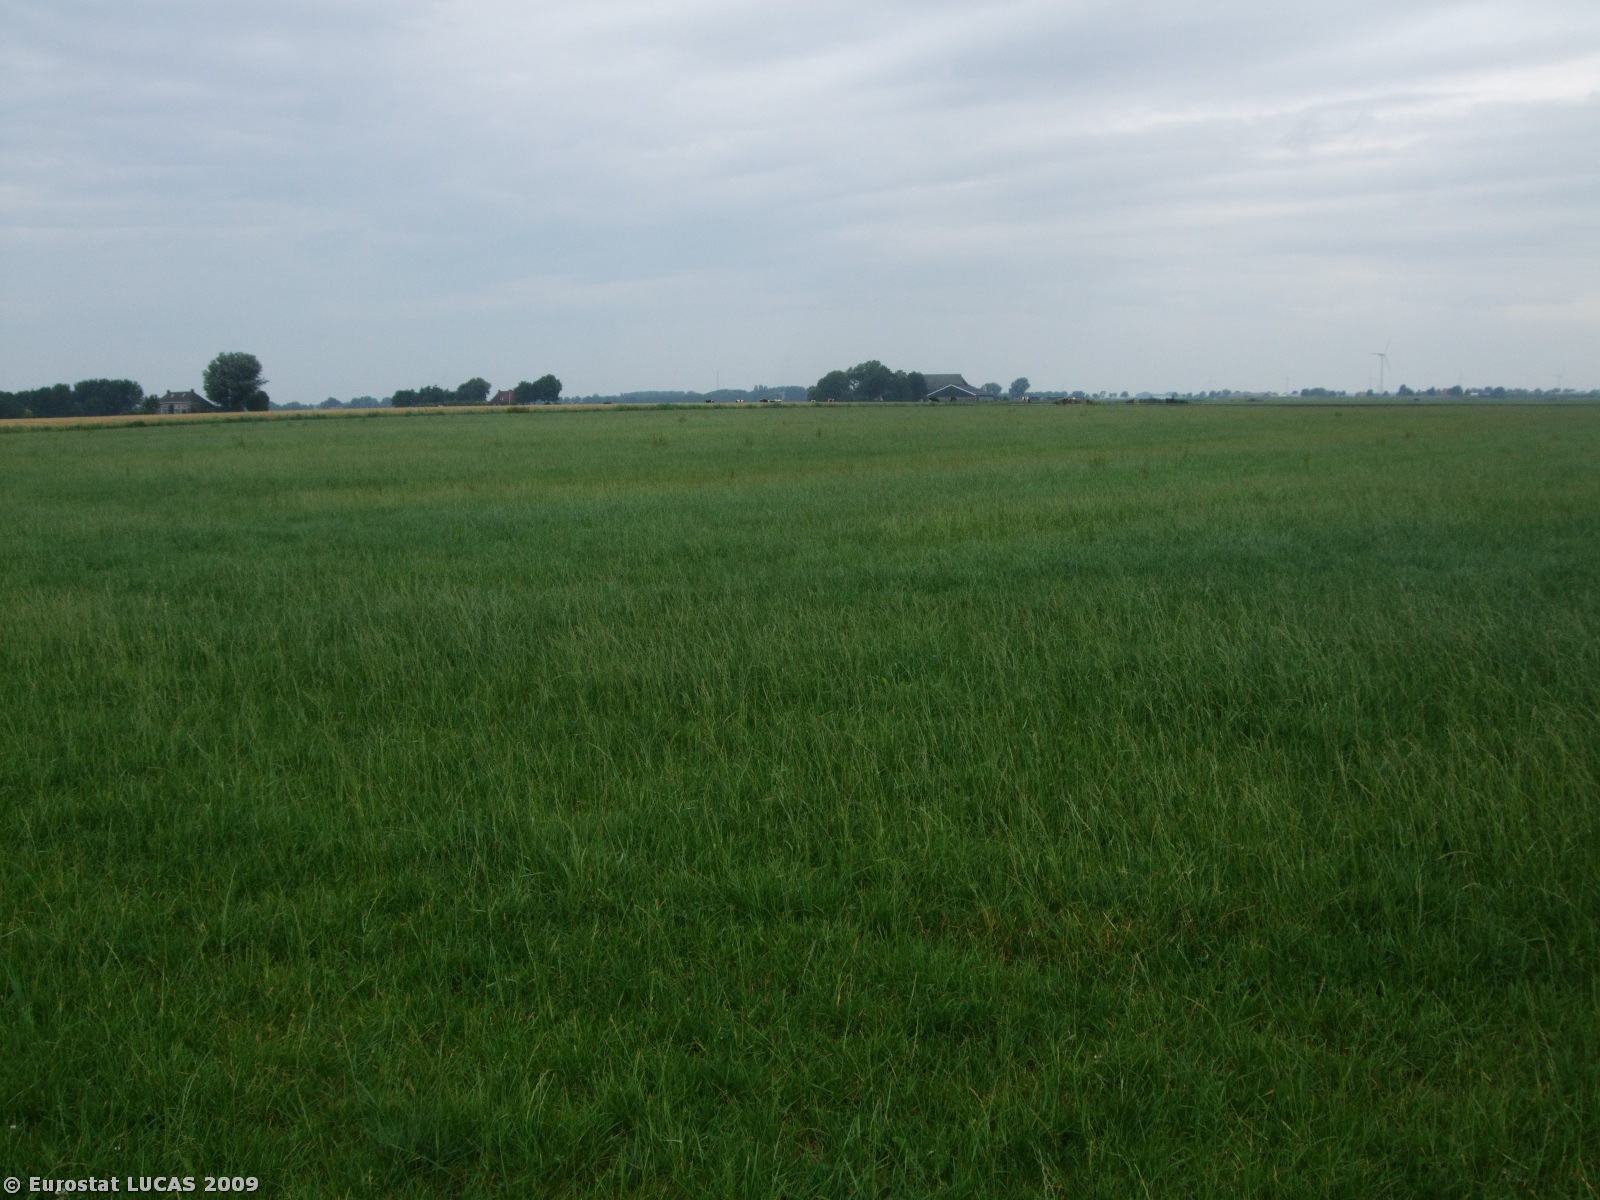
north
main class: Grassland
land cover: Grassland without tree/shrub cover
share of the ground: > 75 %
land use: Agriculture (excluding fallow land and kitchen gardens)
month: July
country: NL
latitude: 53.1786
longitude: 5.6149
